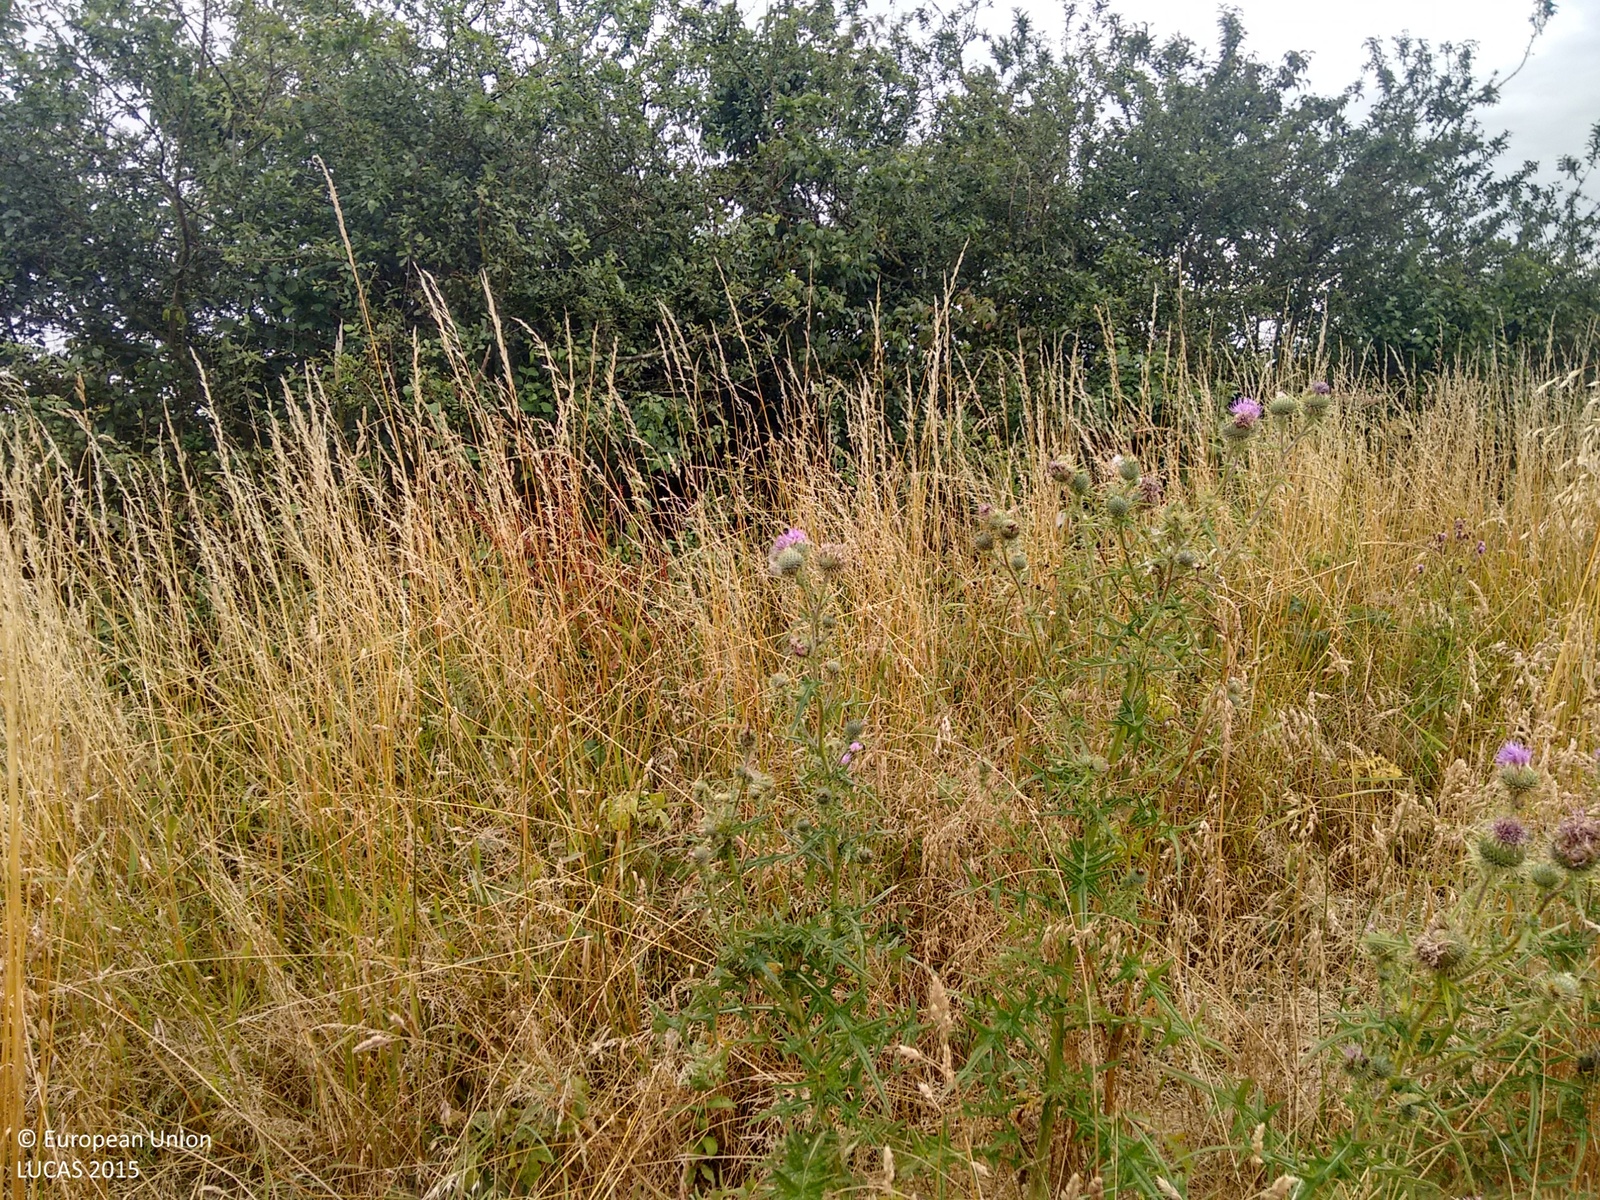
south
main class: Cropland
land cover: Common wheat
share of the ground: > 75 %
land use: Agriculture (excluding fallow land and kitchen gardens)
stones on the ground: 10 - 25 %
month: August
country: GB
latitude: 51.9950
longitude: 0.4909
